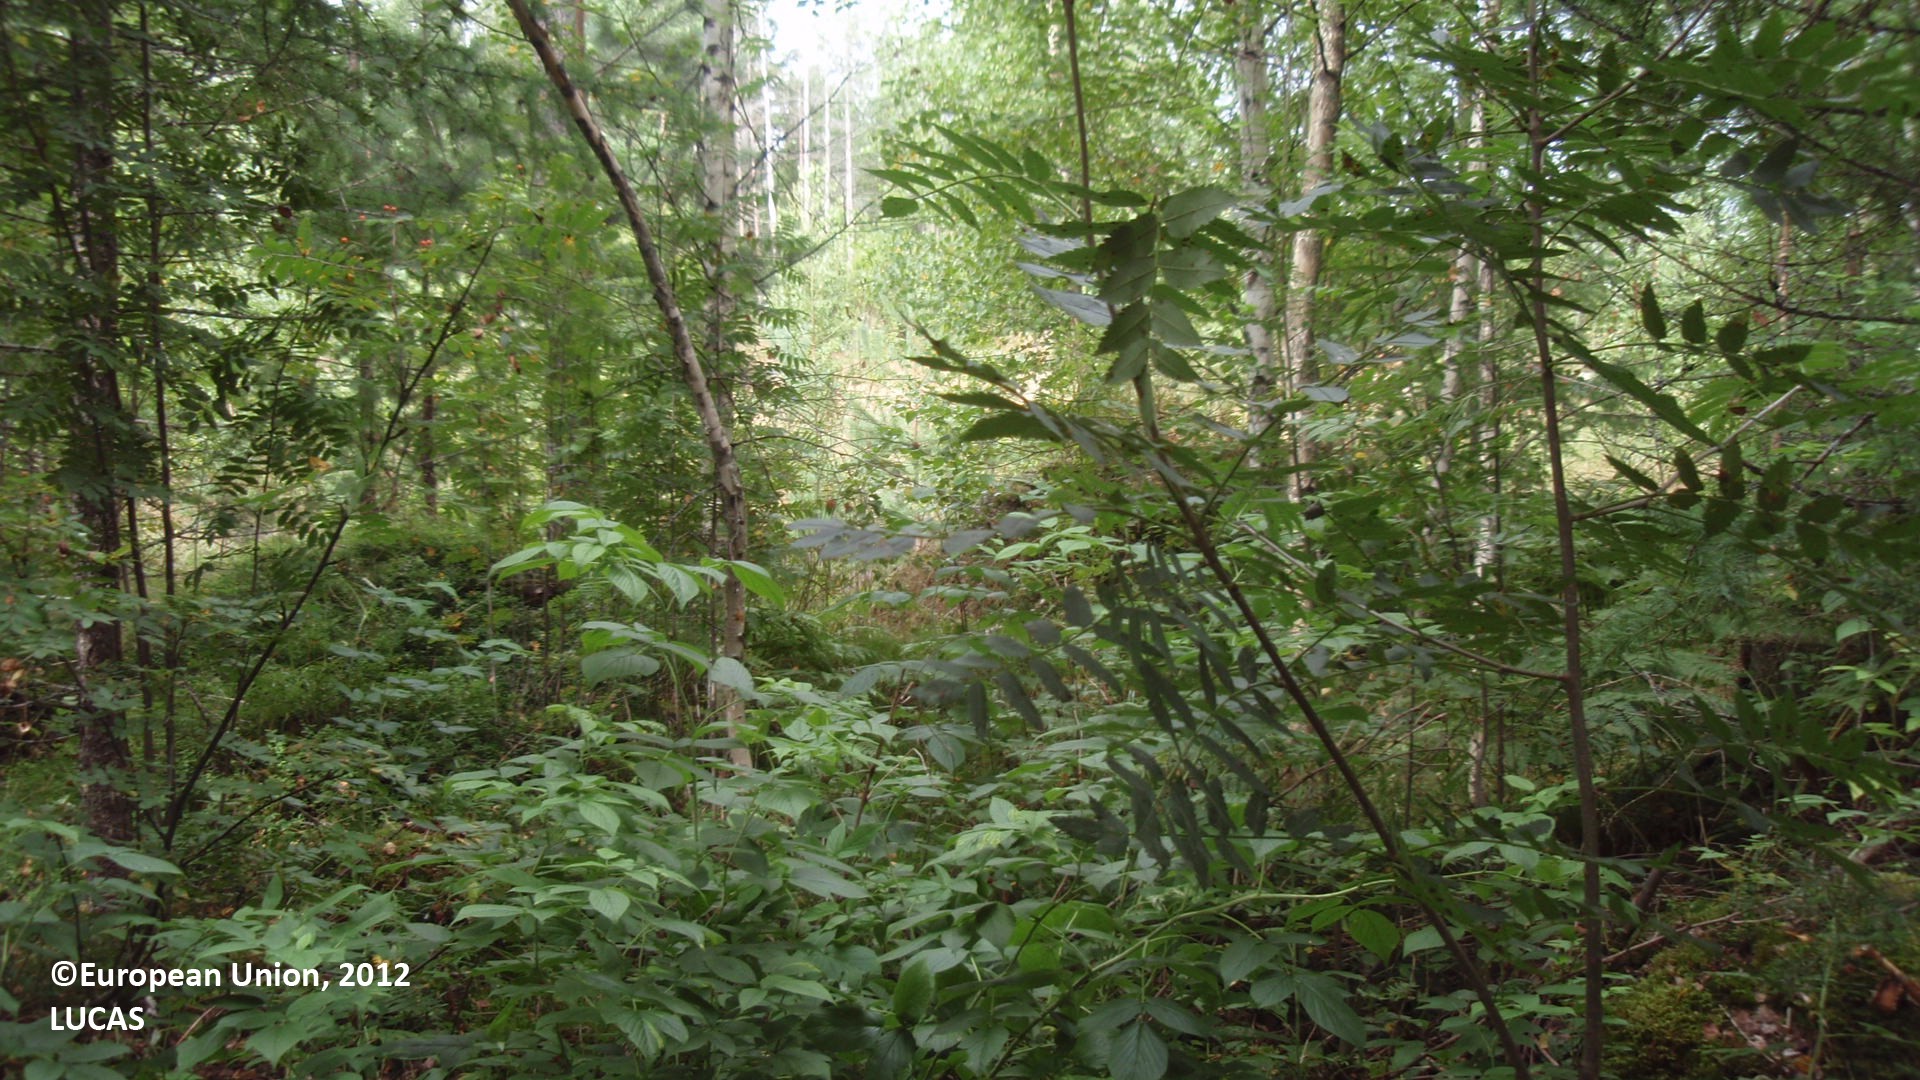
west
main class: Woodland
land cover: Broadleaved woodland
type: non-riverine alder, birch or aspen forest
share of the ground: 50 - 75 %
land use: Forestry
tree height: > 5 m
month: August
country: FI
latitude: 60.9200
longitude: 26.9312
